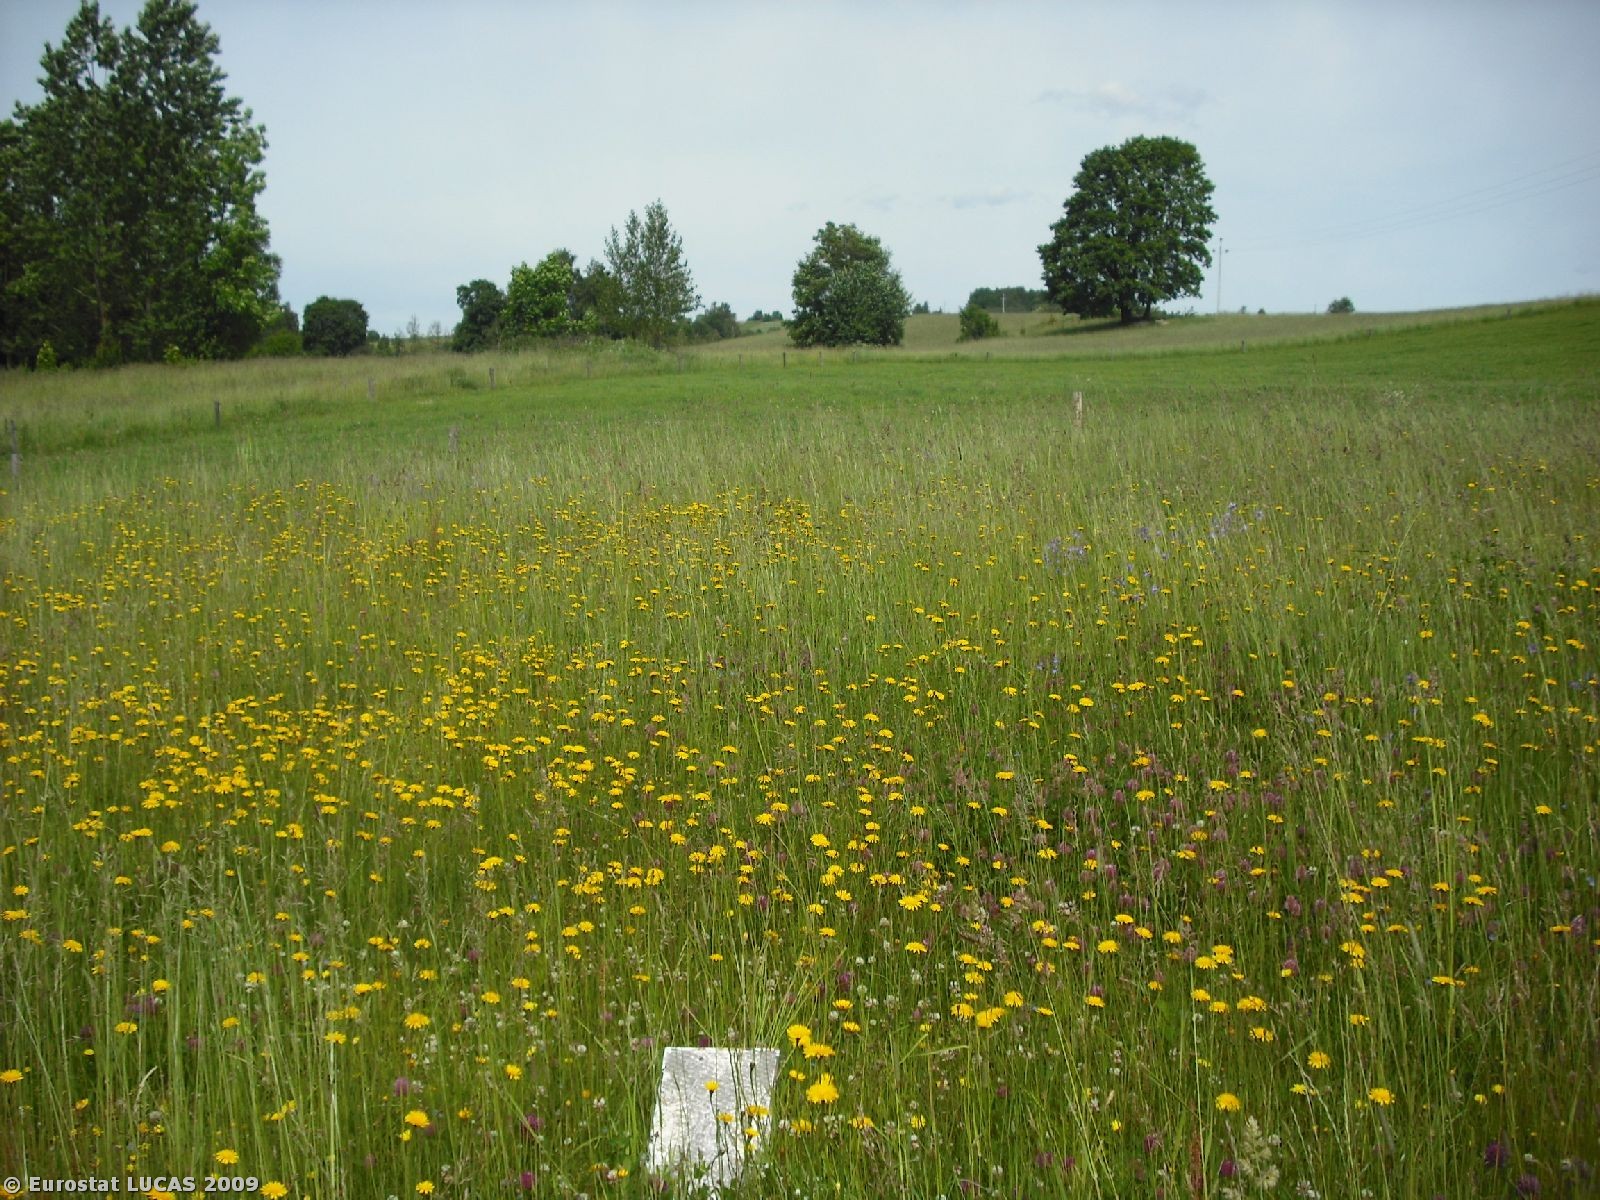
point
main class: Grassland
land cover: Grassland without tree/shrub cover
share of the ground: > 75 %
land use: Agriculture (excluding fallow land and kitchen gardens)
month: June
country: PL
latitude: 54.2967
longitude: 22.8698
